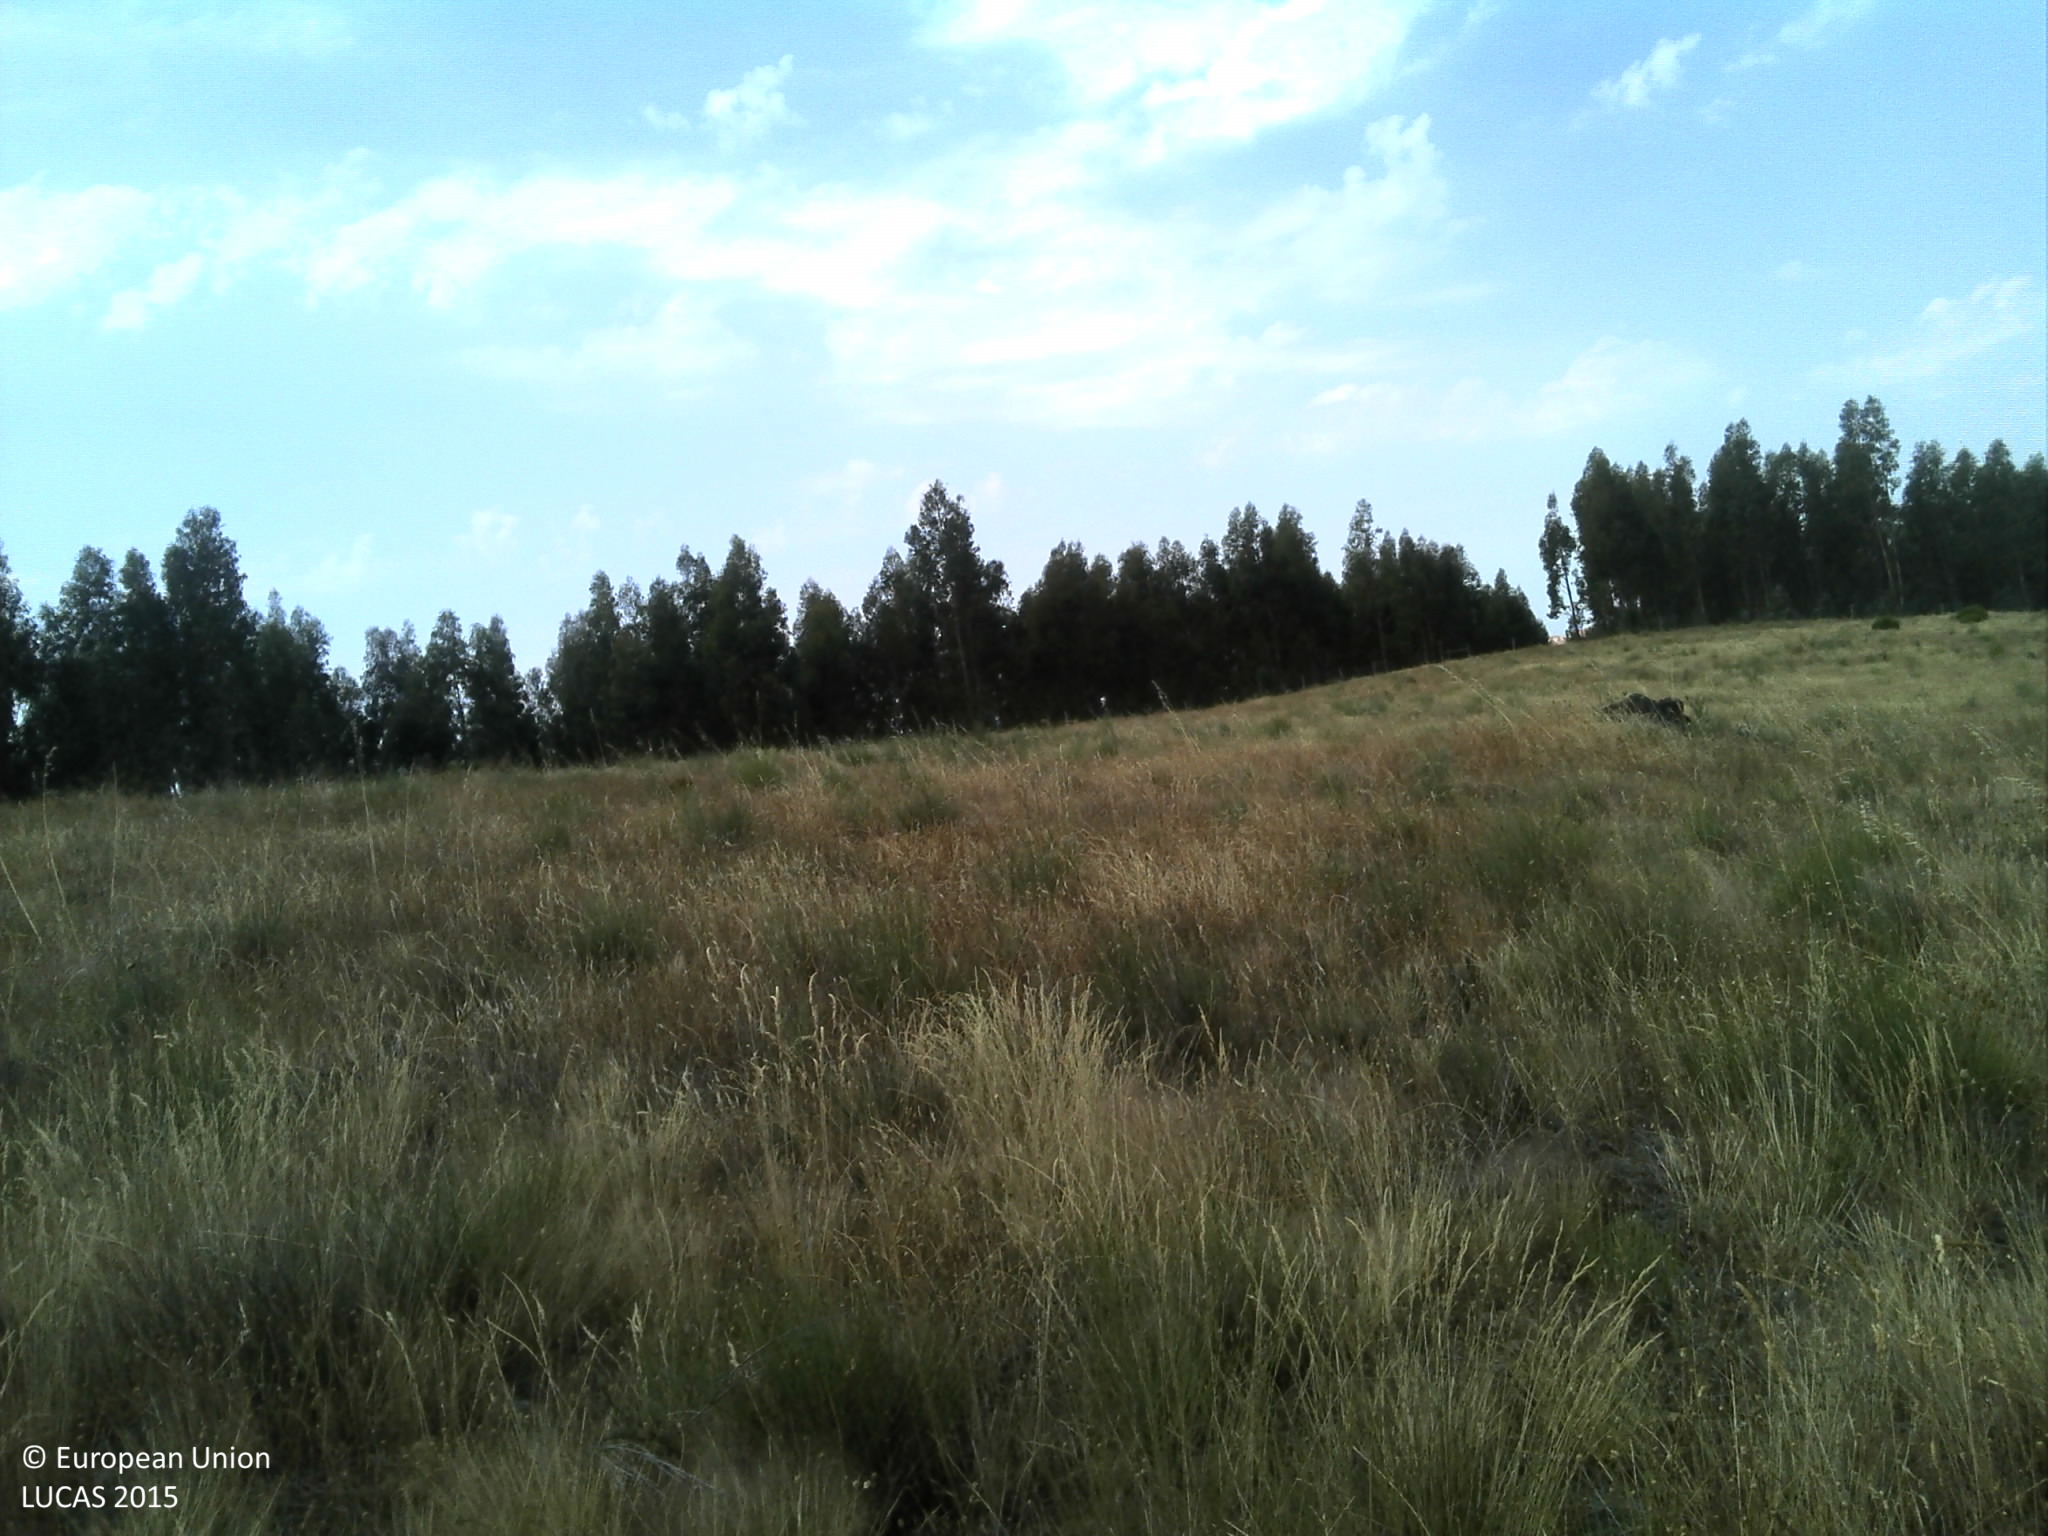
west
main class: Grassland
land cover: Grassland with sparse tree/shrub cover
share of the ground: 50 - 75 %
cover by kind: herbaceous plants 65 %, unconsolidated bare surface 25 %, broadleaved forest trees 5 %
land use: Agriculture (excluding fallow land and kitchen gardens)
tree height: > 5 m
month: June
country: PT
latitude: 40.1850
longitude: -7.1389
